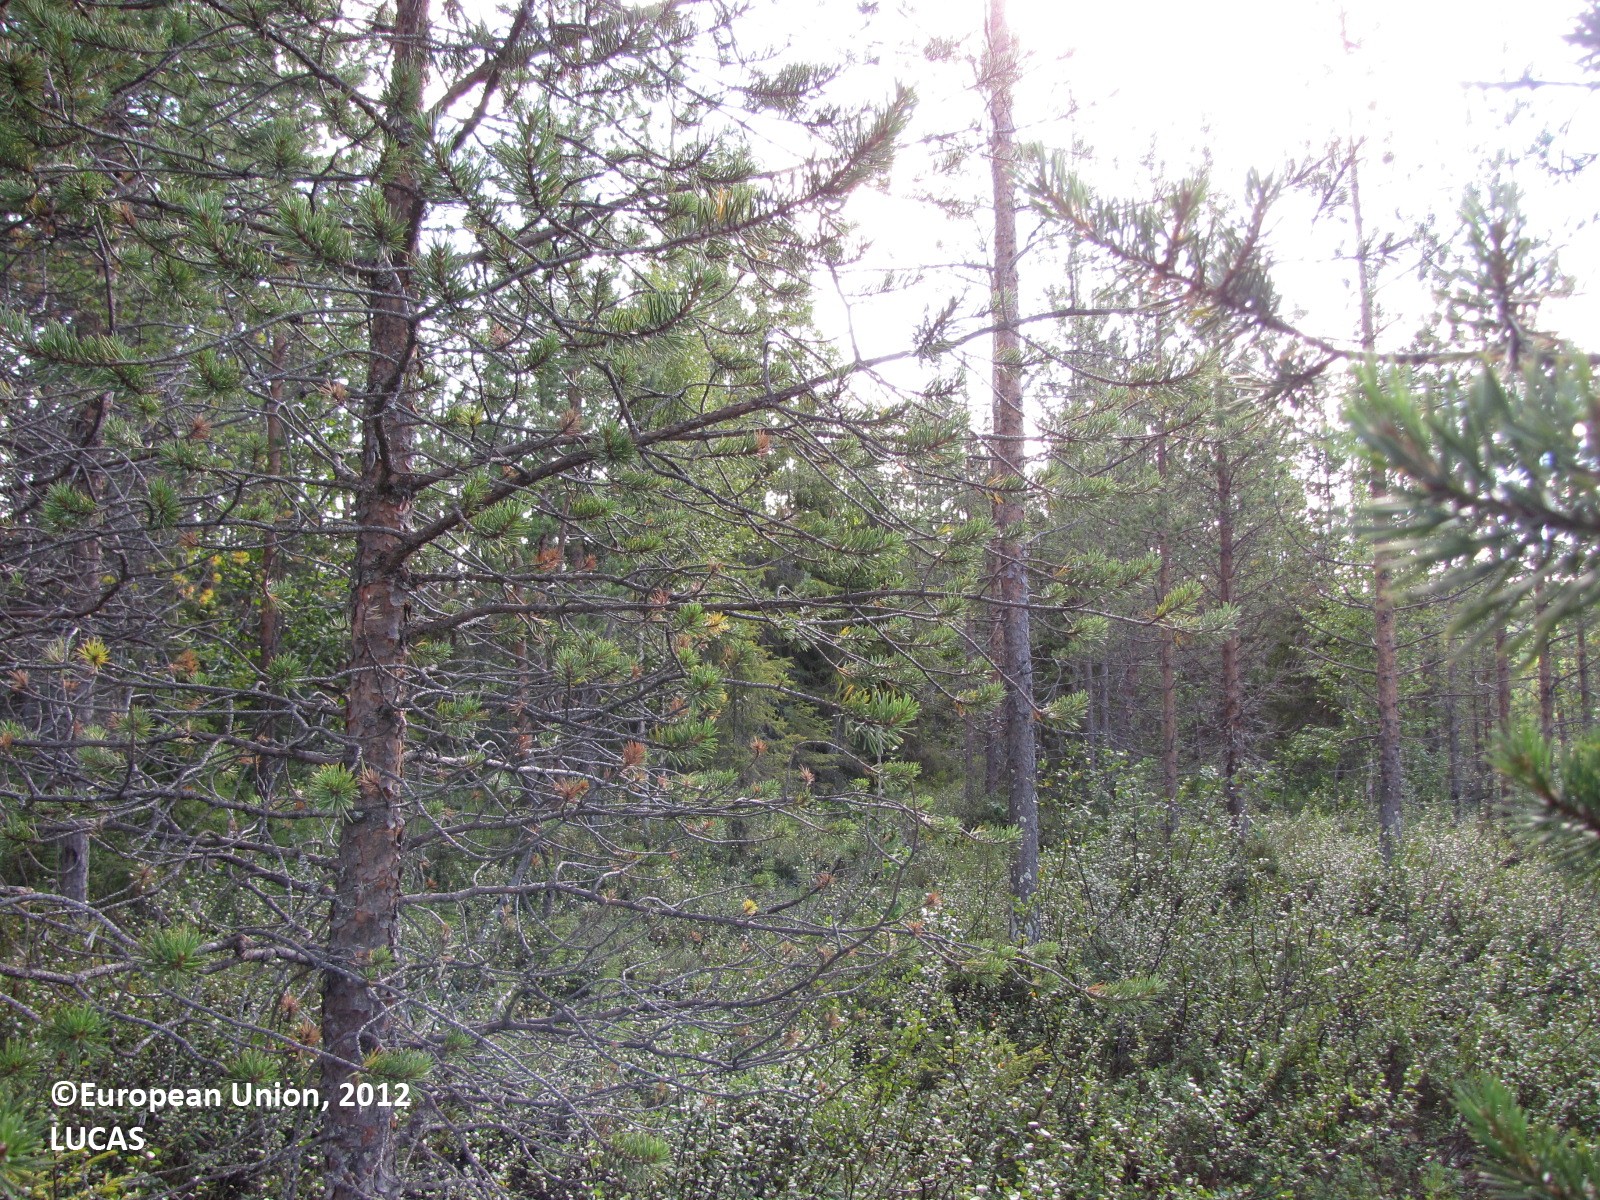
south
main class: Woodland
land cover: Pine dominated coniferous woodland
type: boreal forest
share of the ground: 50 - 75 %
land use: Forestry
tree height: > 5 m
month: August
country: FI
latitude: 66.8490
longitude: 25.1175
